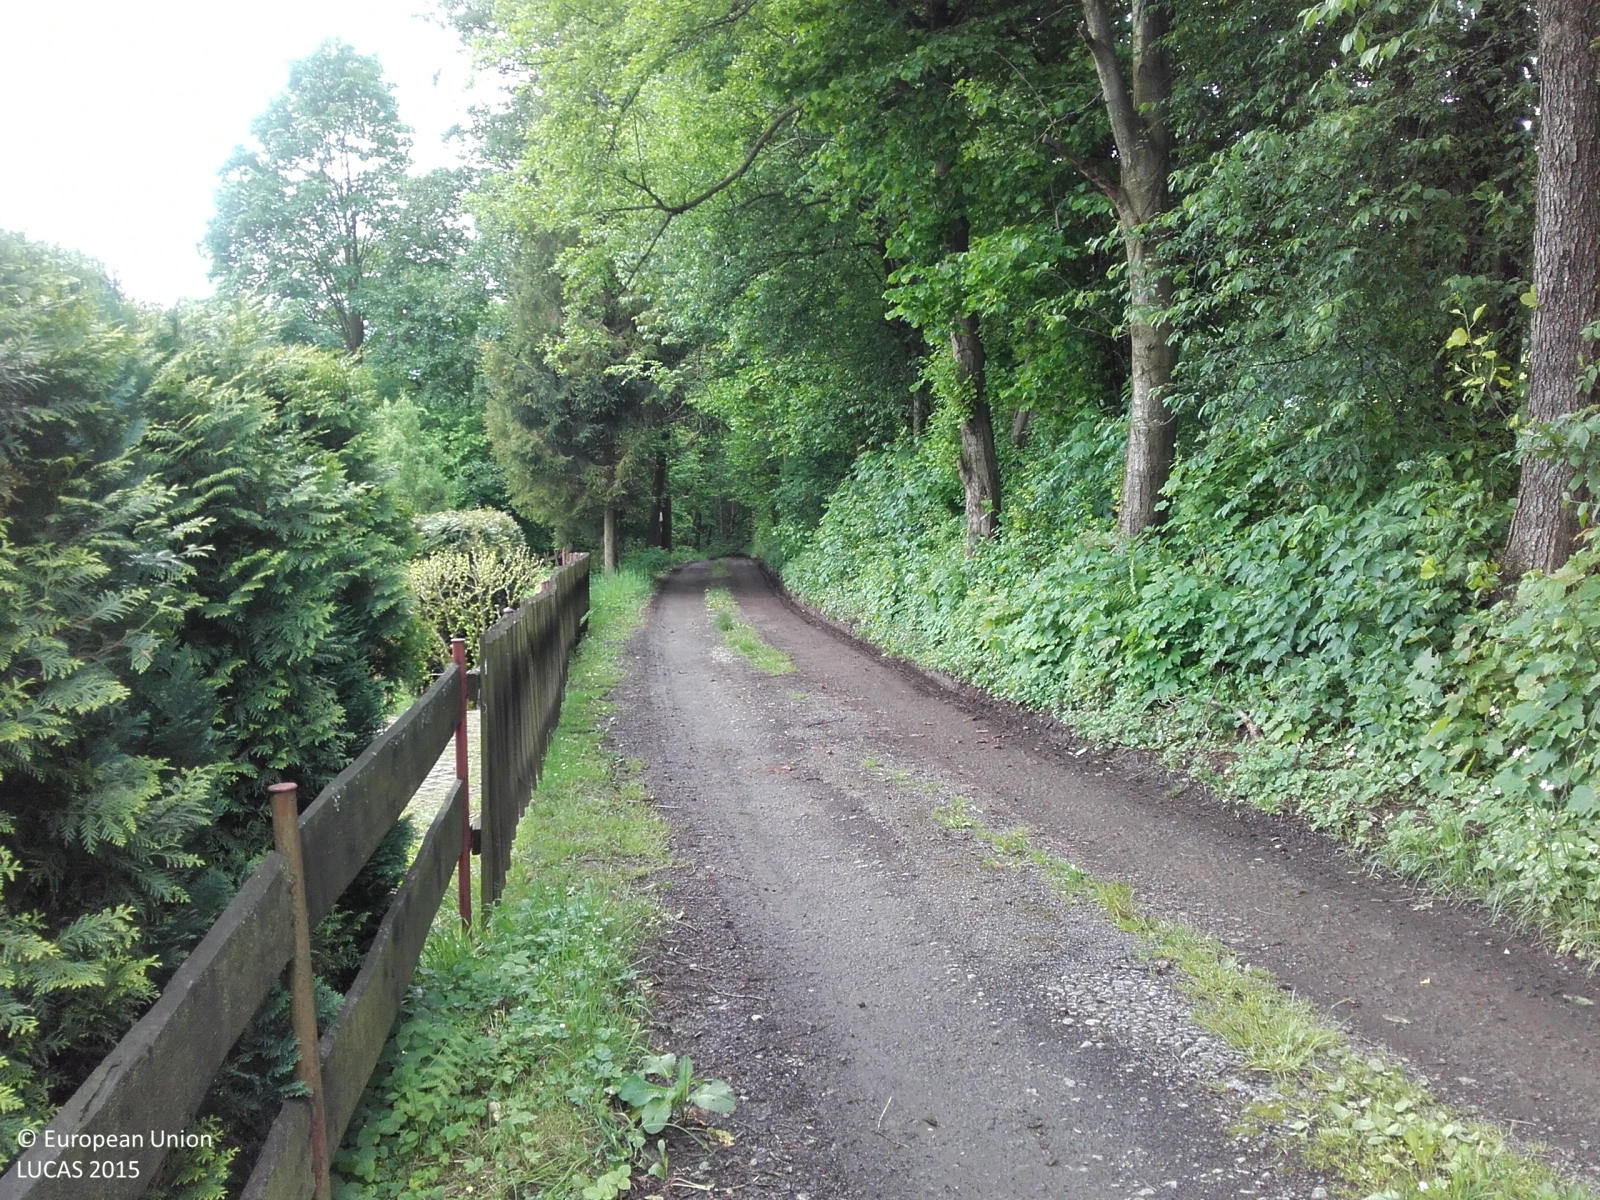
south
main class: Grassland
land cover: Grassland without tree/shrub cover
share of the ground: > 75 %
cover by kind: herbaceous plants 100 %
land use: Residential
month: May
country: CZ
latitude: 49.6654
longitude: 18.7630
